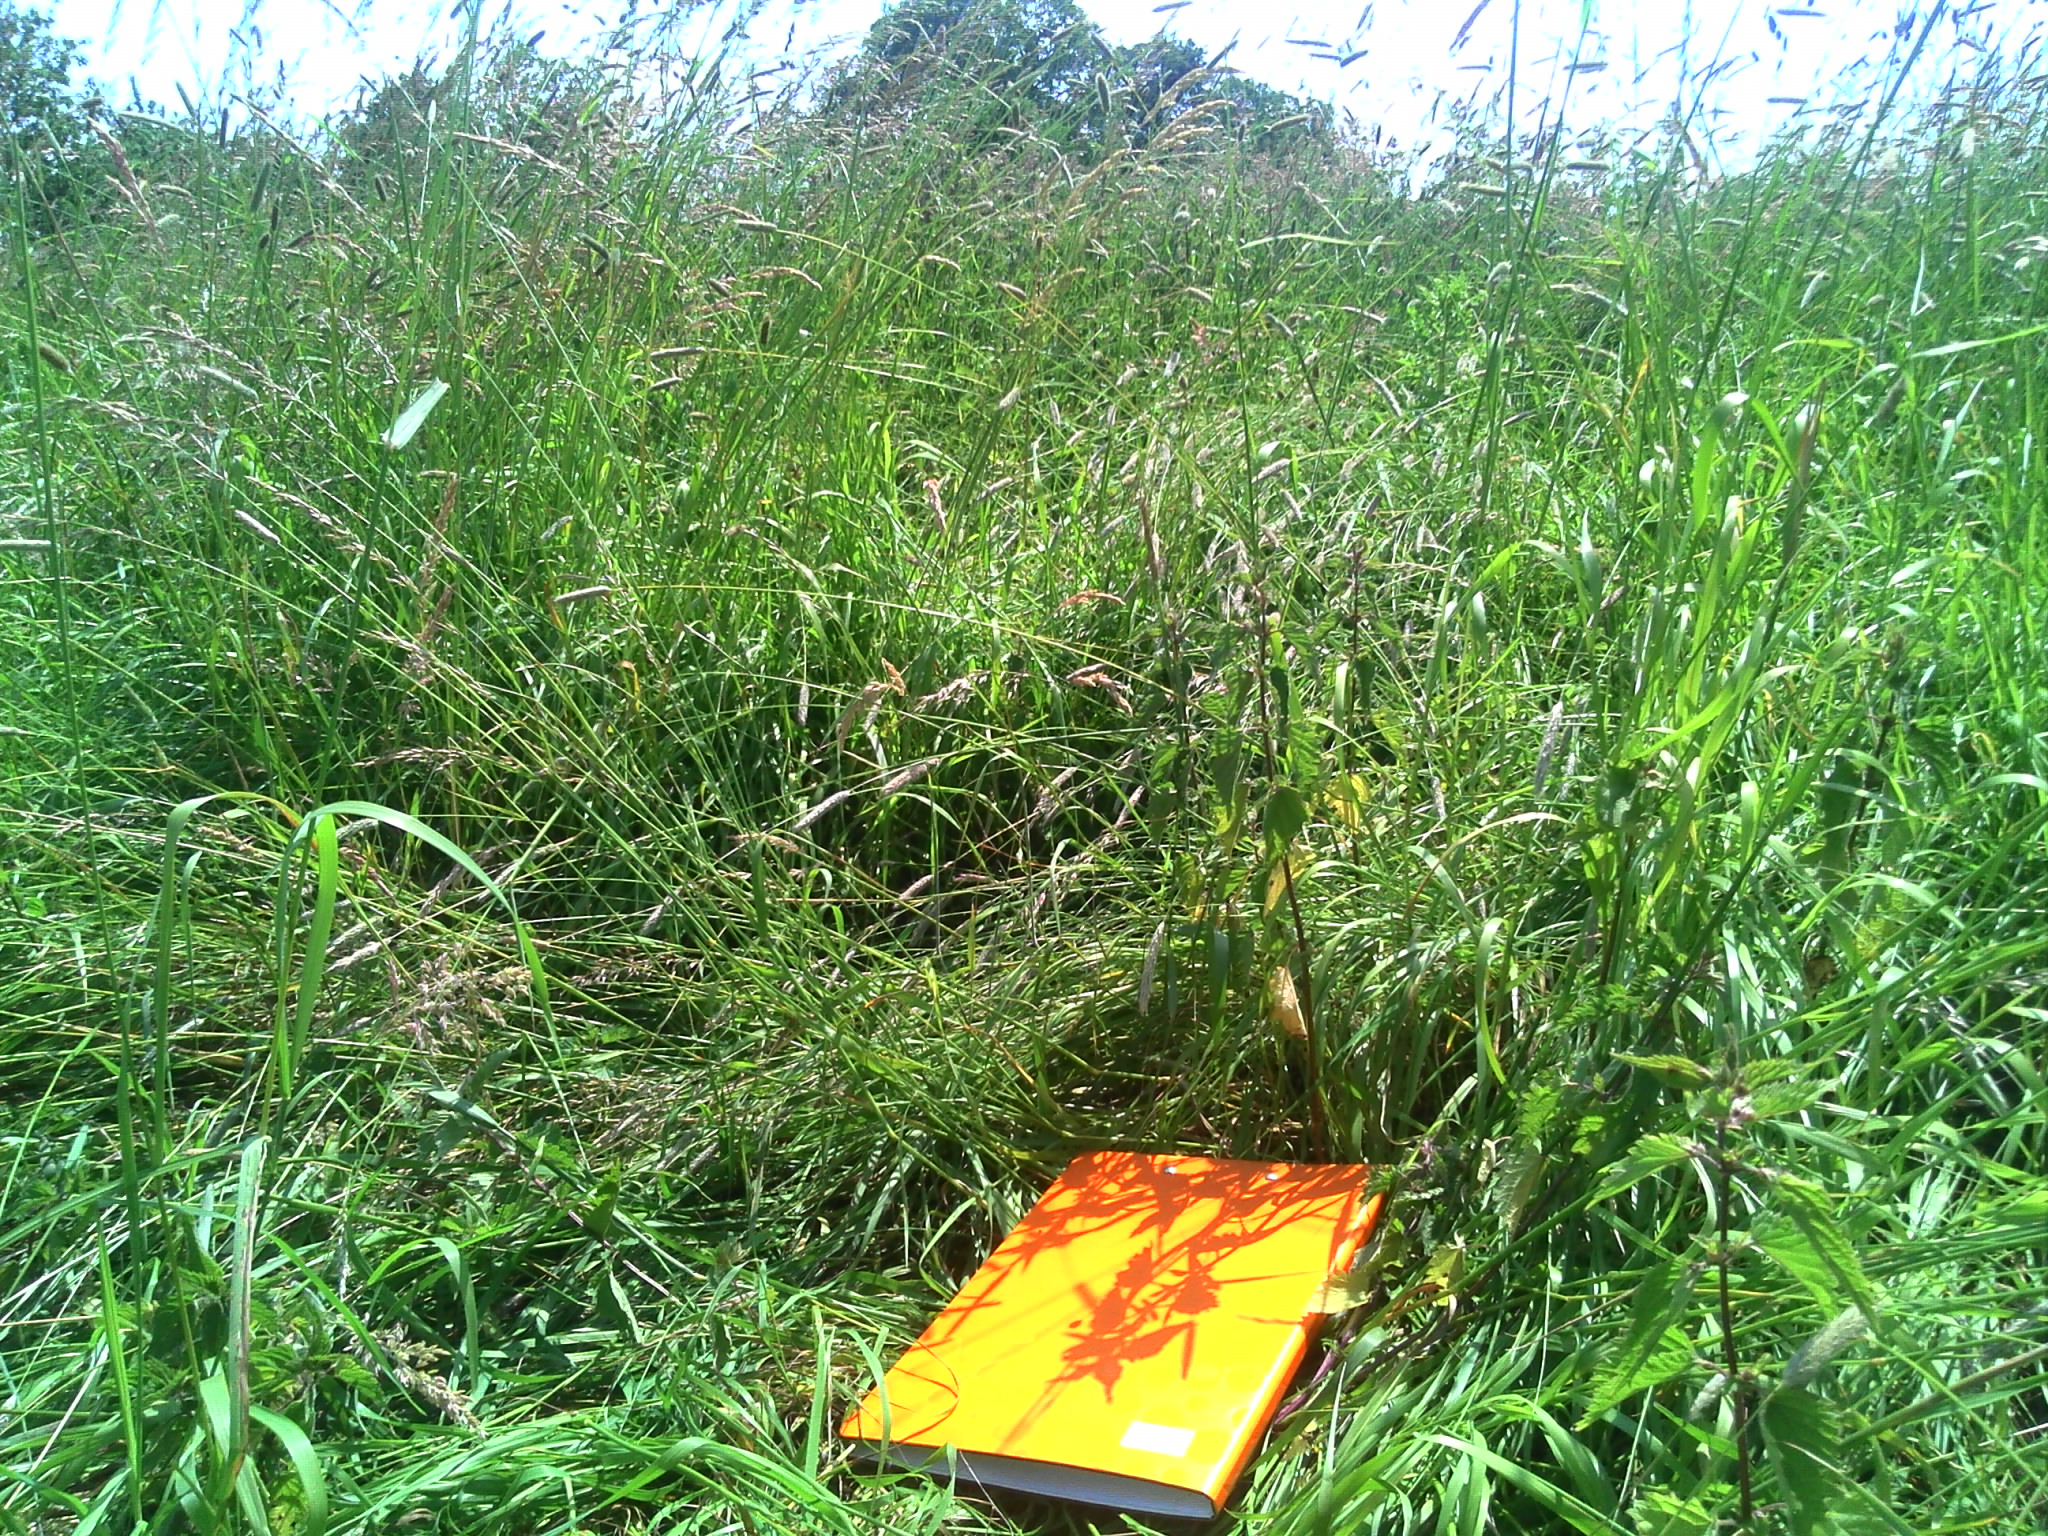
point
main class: Grassland
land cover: Grassland without tree/shrub cover
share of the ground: > 75 %
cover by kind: herbaceous plants 100 %
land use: Agriculture (excluding fallow land and kitchen gardens)
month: June
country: BE
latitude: 50.9079
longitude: 4.3208
